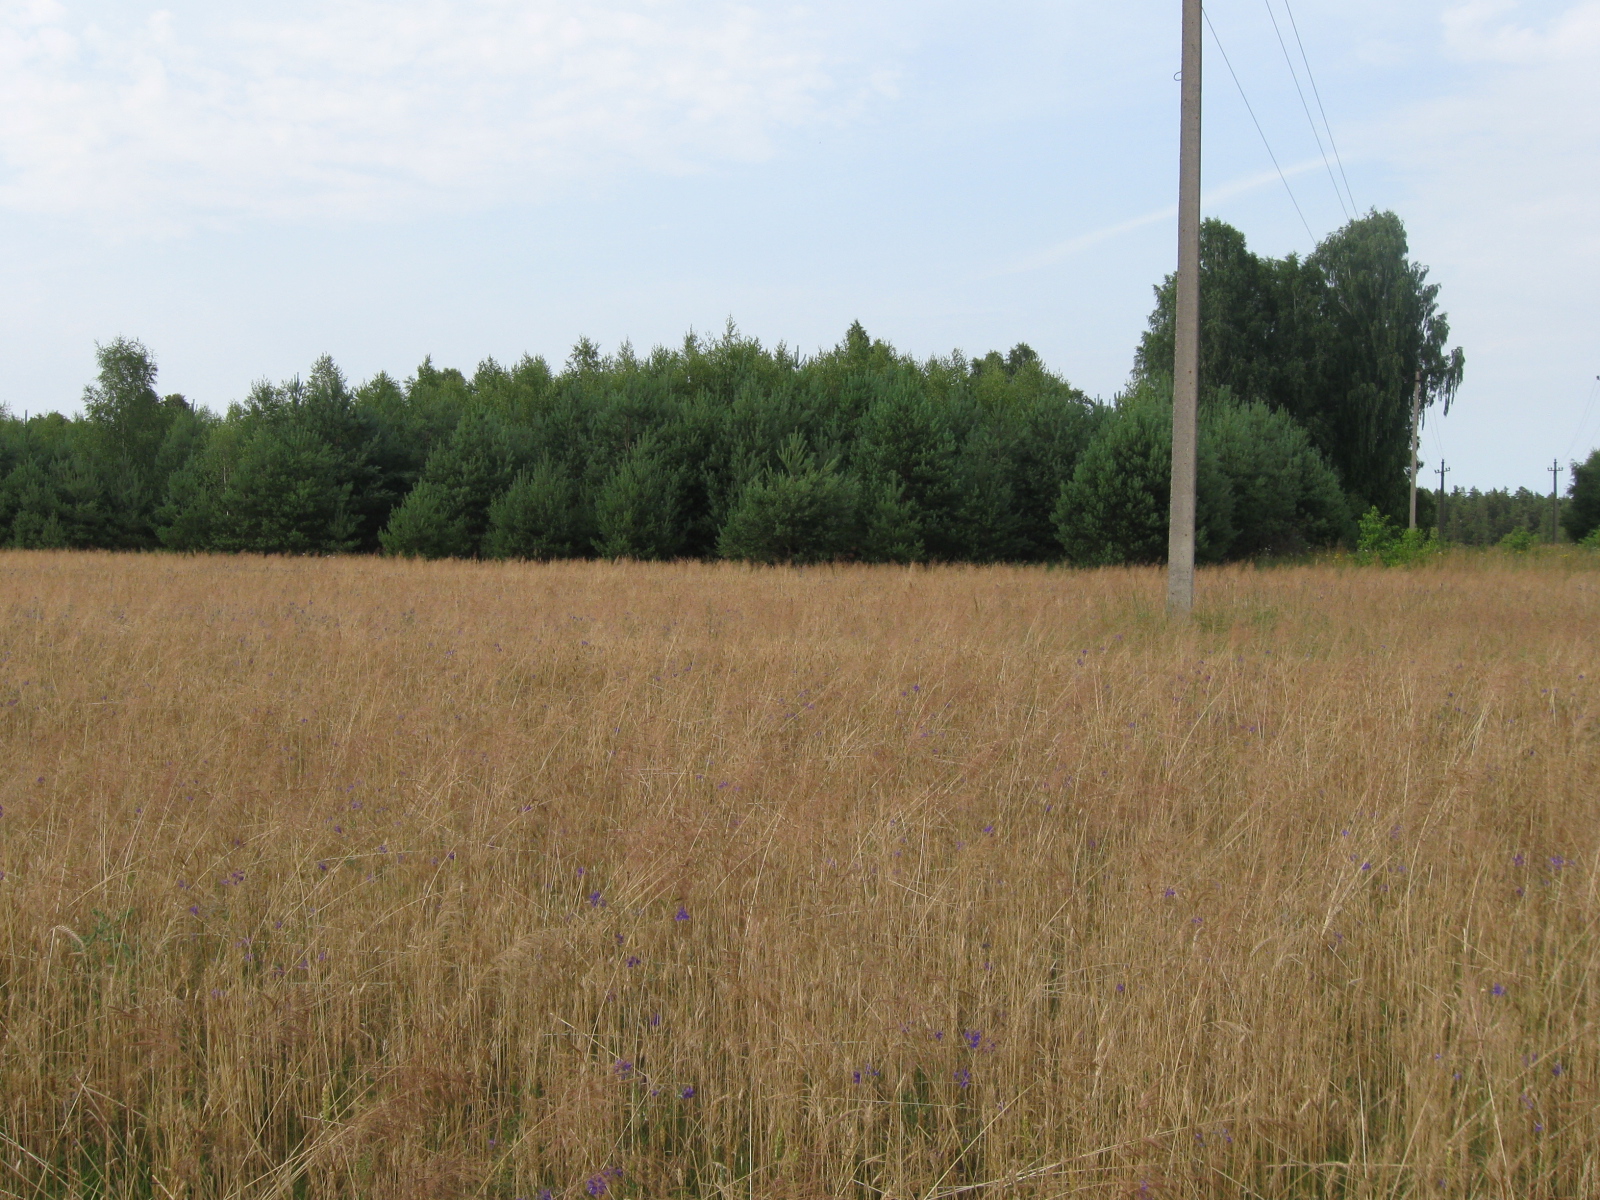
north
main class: Cropland
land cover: Durum wheat
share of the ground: > 75 %
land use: Agriculture (excluding fallow land and kitchen gardens)
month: July
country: LT
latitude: 54.6130
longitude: 23.9807
